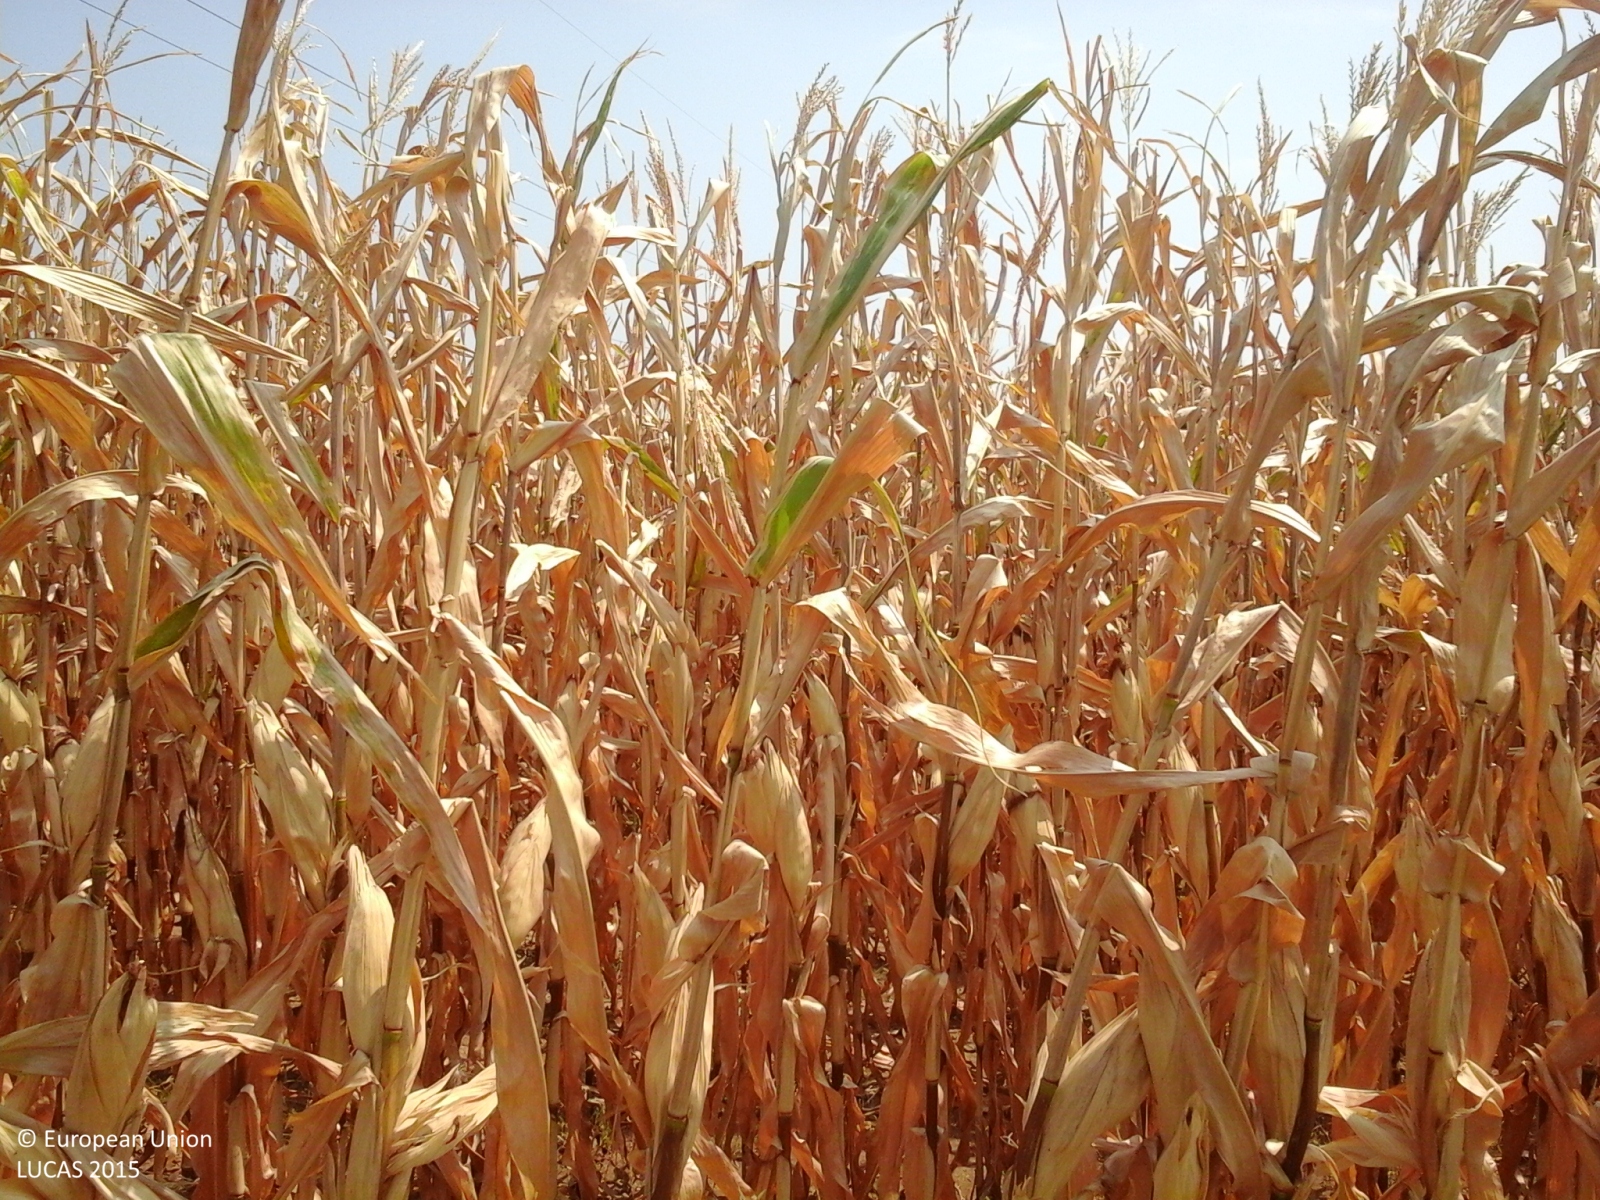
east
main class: Cropland
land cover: Maize
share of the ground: > 75 %
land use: Agriculture (excluding fallow land and kitchen gardens)
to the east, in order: Maize; Electric lines; Maize; Grass margins; Maize; Grass margins; Durum wheat; Grass margins; Ditches and canals; Durum wheat
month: August
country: IT
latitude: 43.4810
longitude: 13.4410
